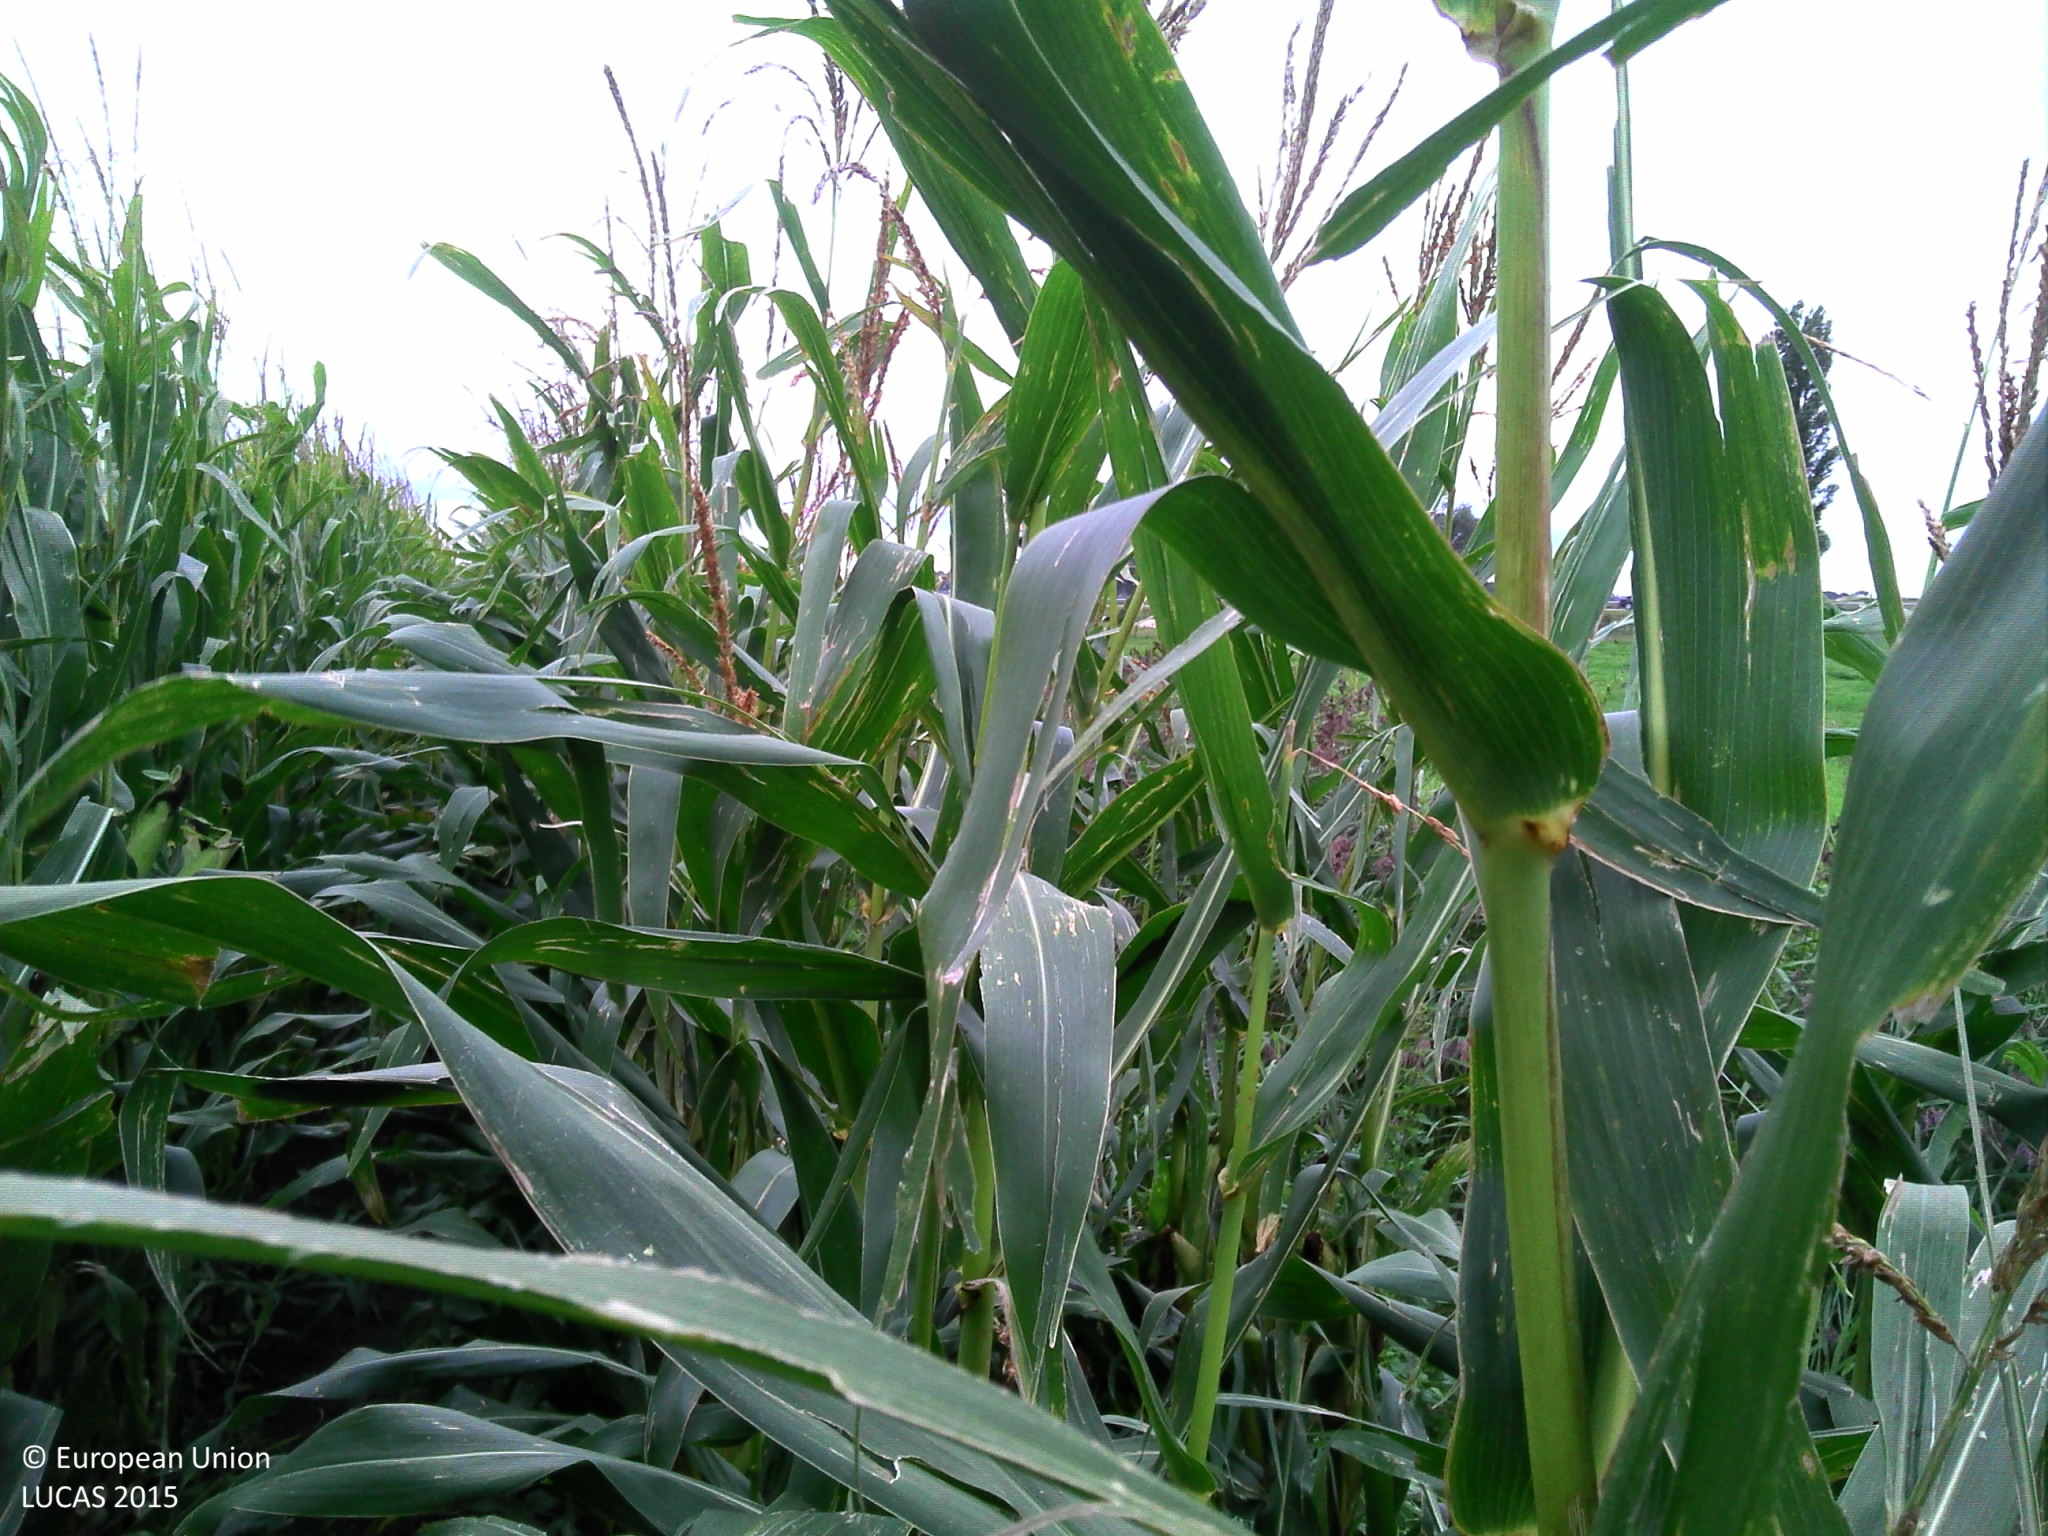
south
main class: Cropland
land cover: Maize
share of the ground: > 75 %
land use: Agriculture (excluding fallow land and kitchen gardens)
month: September
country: BE
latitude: 51.1405
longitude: 2.9719
